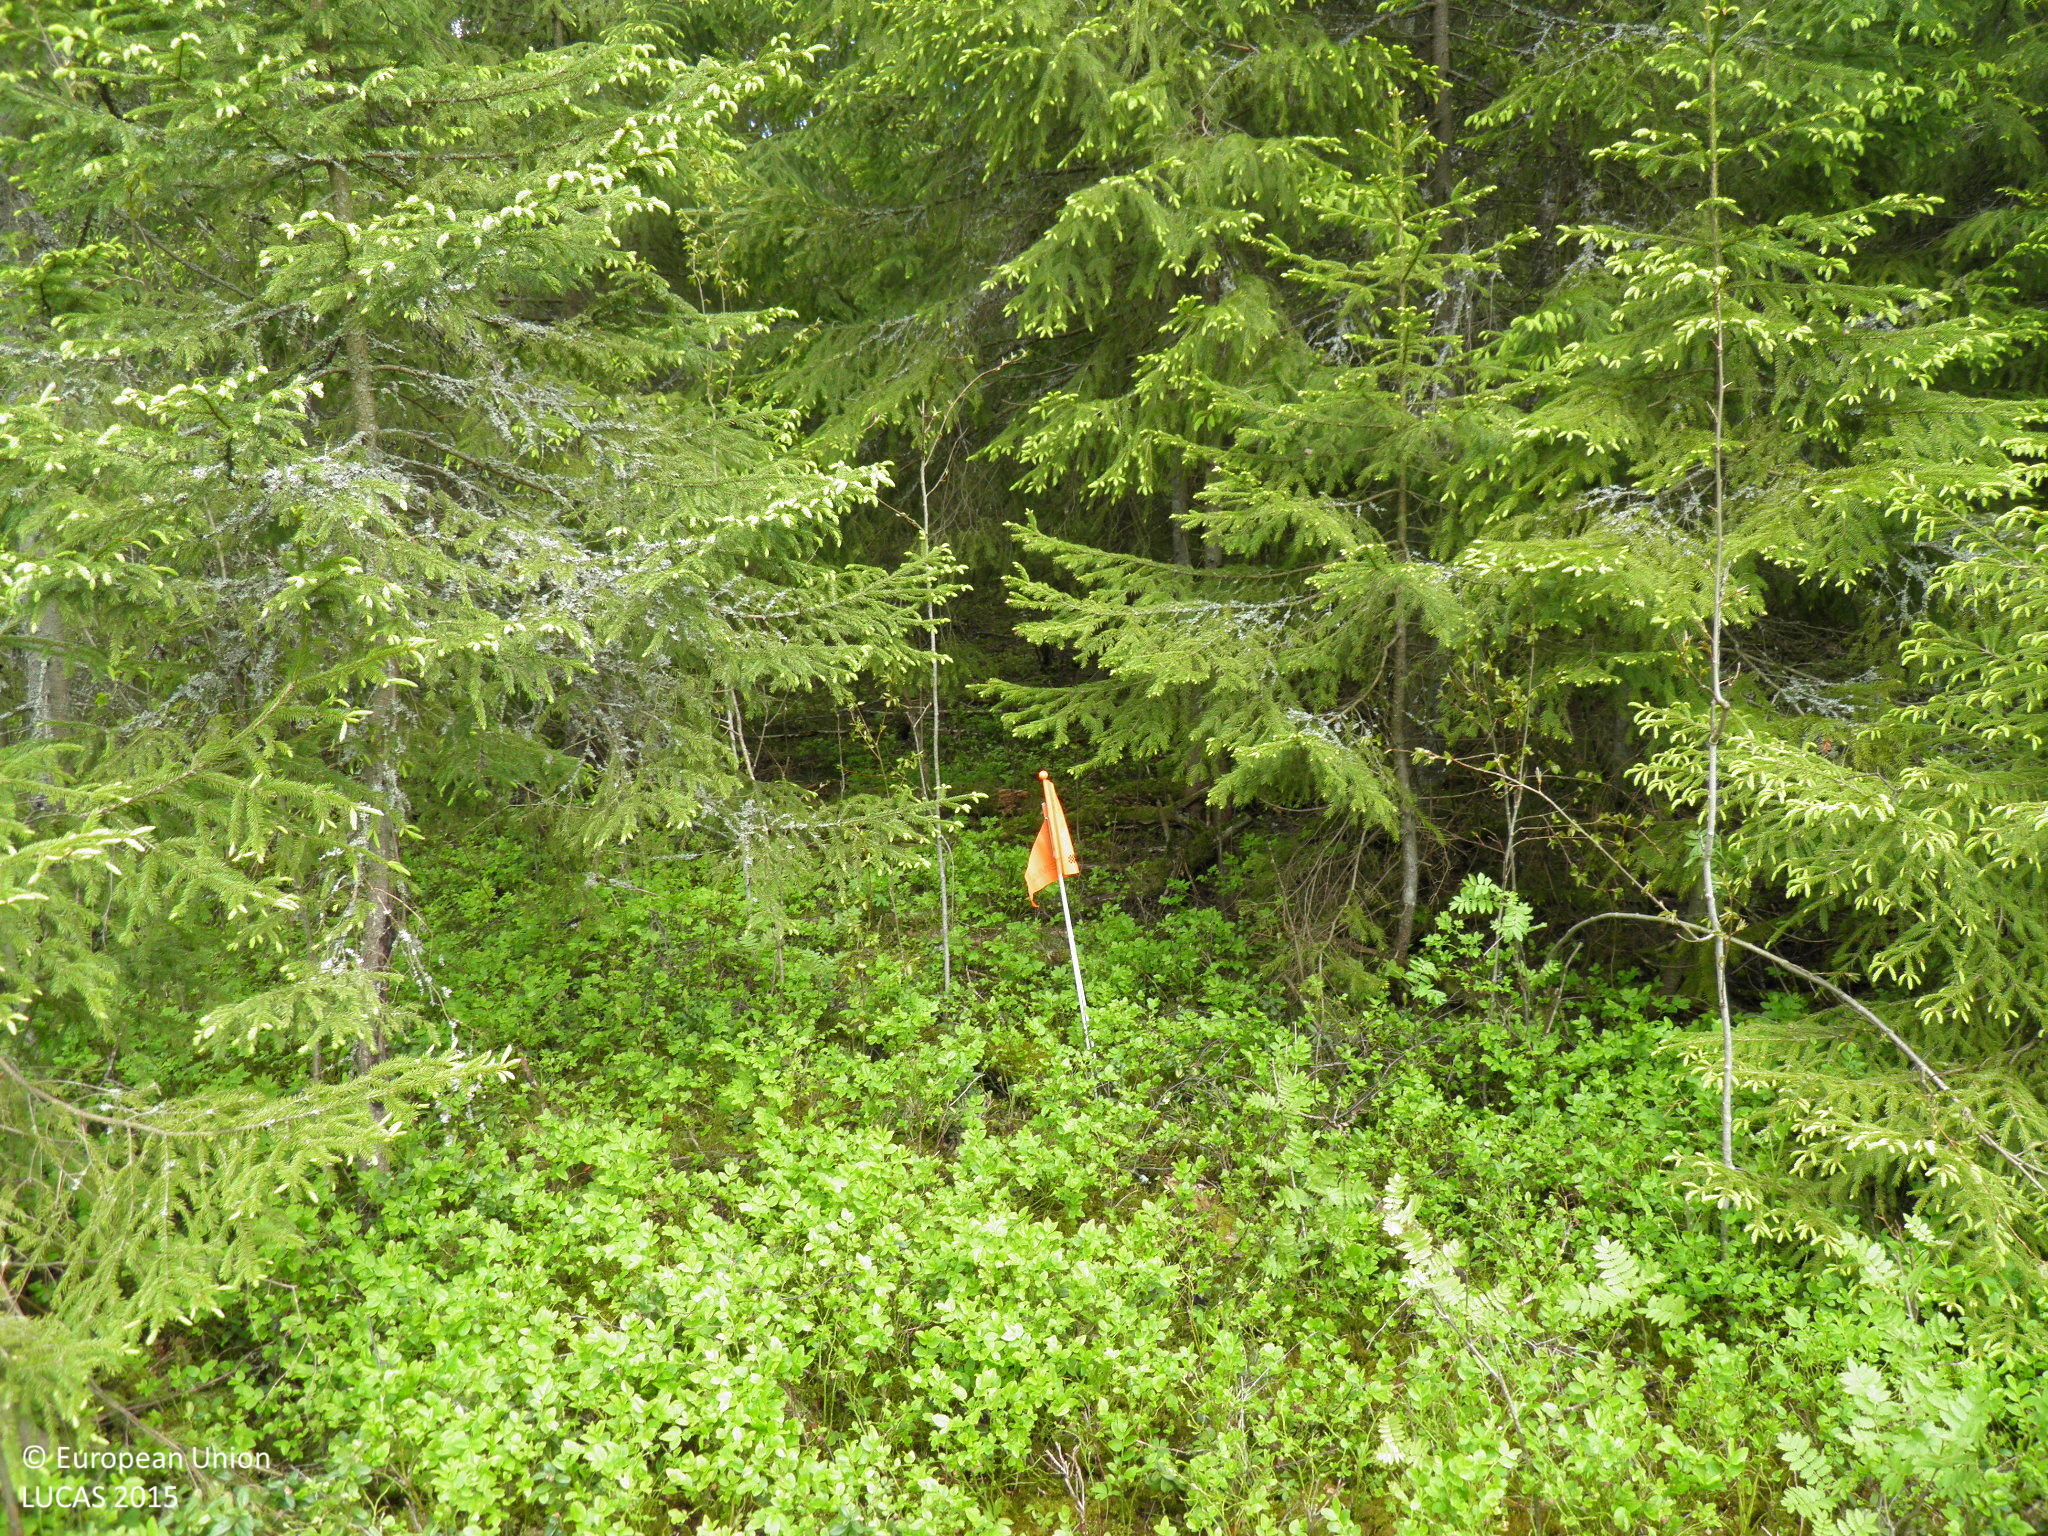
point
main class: Woodland
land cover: Spruce dominated mixed woodland
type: boreal forest
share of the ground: > 75 %
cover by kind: coniferous forest trees 65 %, broadleaved forest trees 25 %, shrubs 10 %
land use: Forestry
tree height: > 5 m
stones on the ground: < 10 %
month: May
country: FI
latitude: 60.3724
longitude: 22.2721
